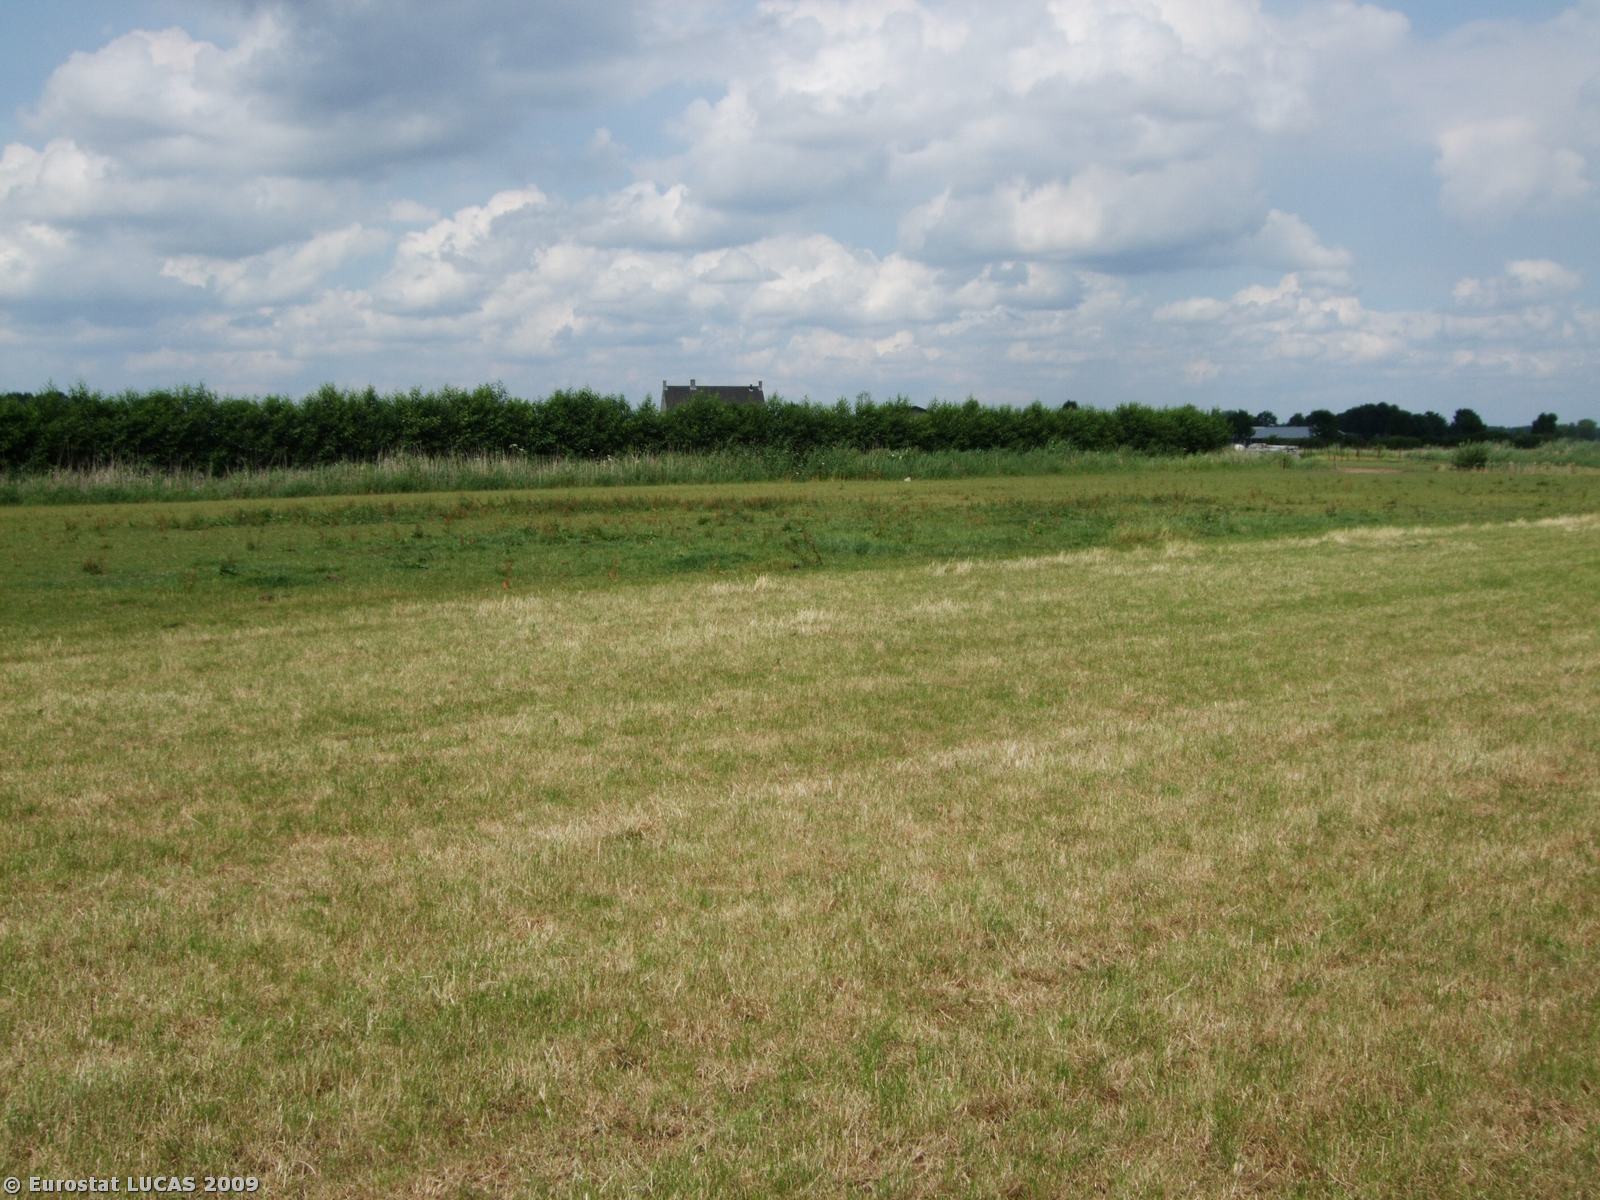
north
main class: Grassland
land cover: Grassland without tree/shrub cover
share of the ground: > 75 %
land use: Agriculture (excluding fallow land and kitchen gardens)
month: July
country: NL
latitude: 51.8897
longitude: 5.3338
